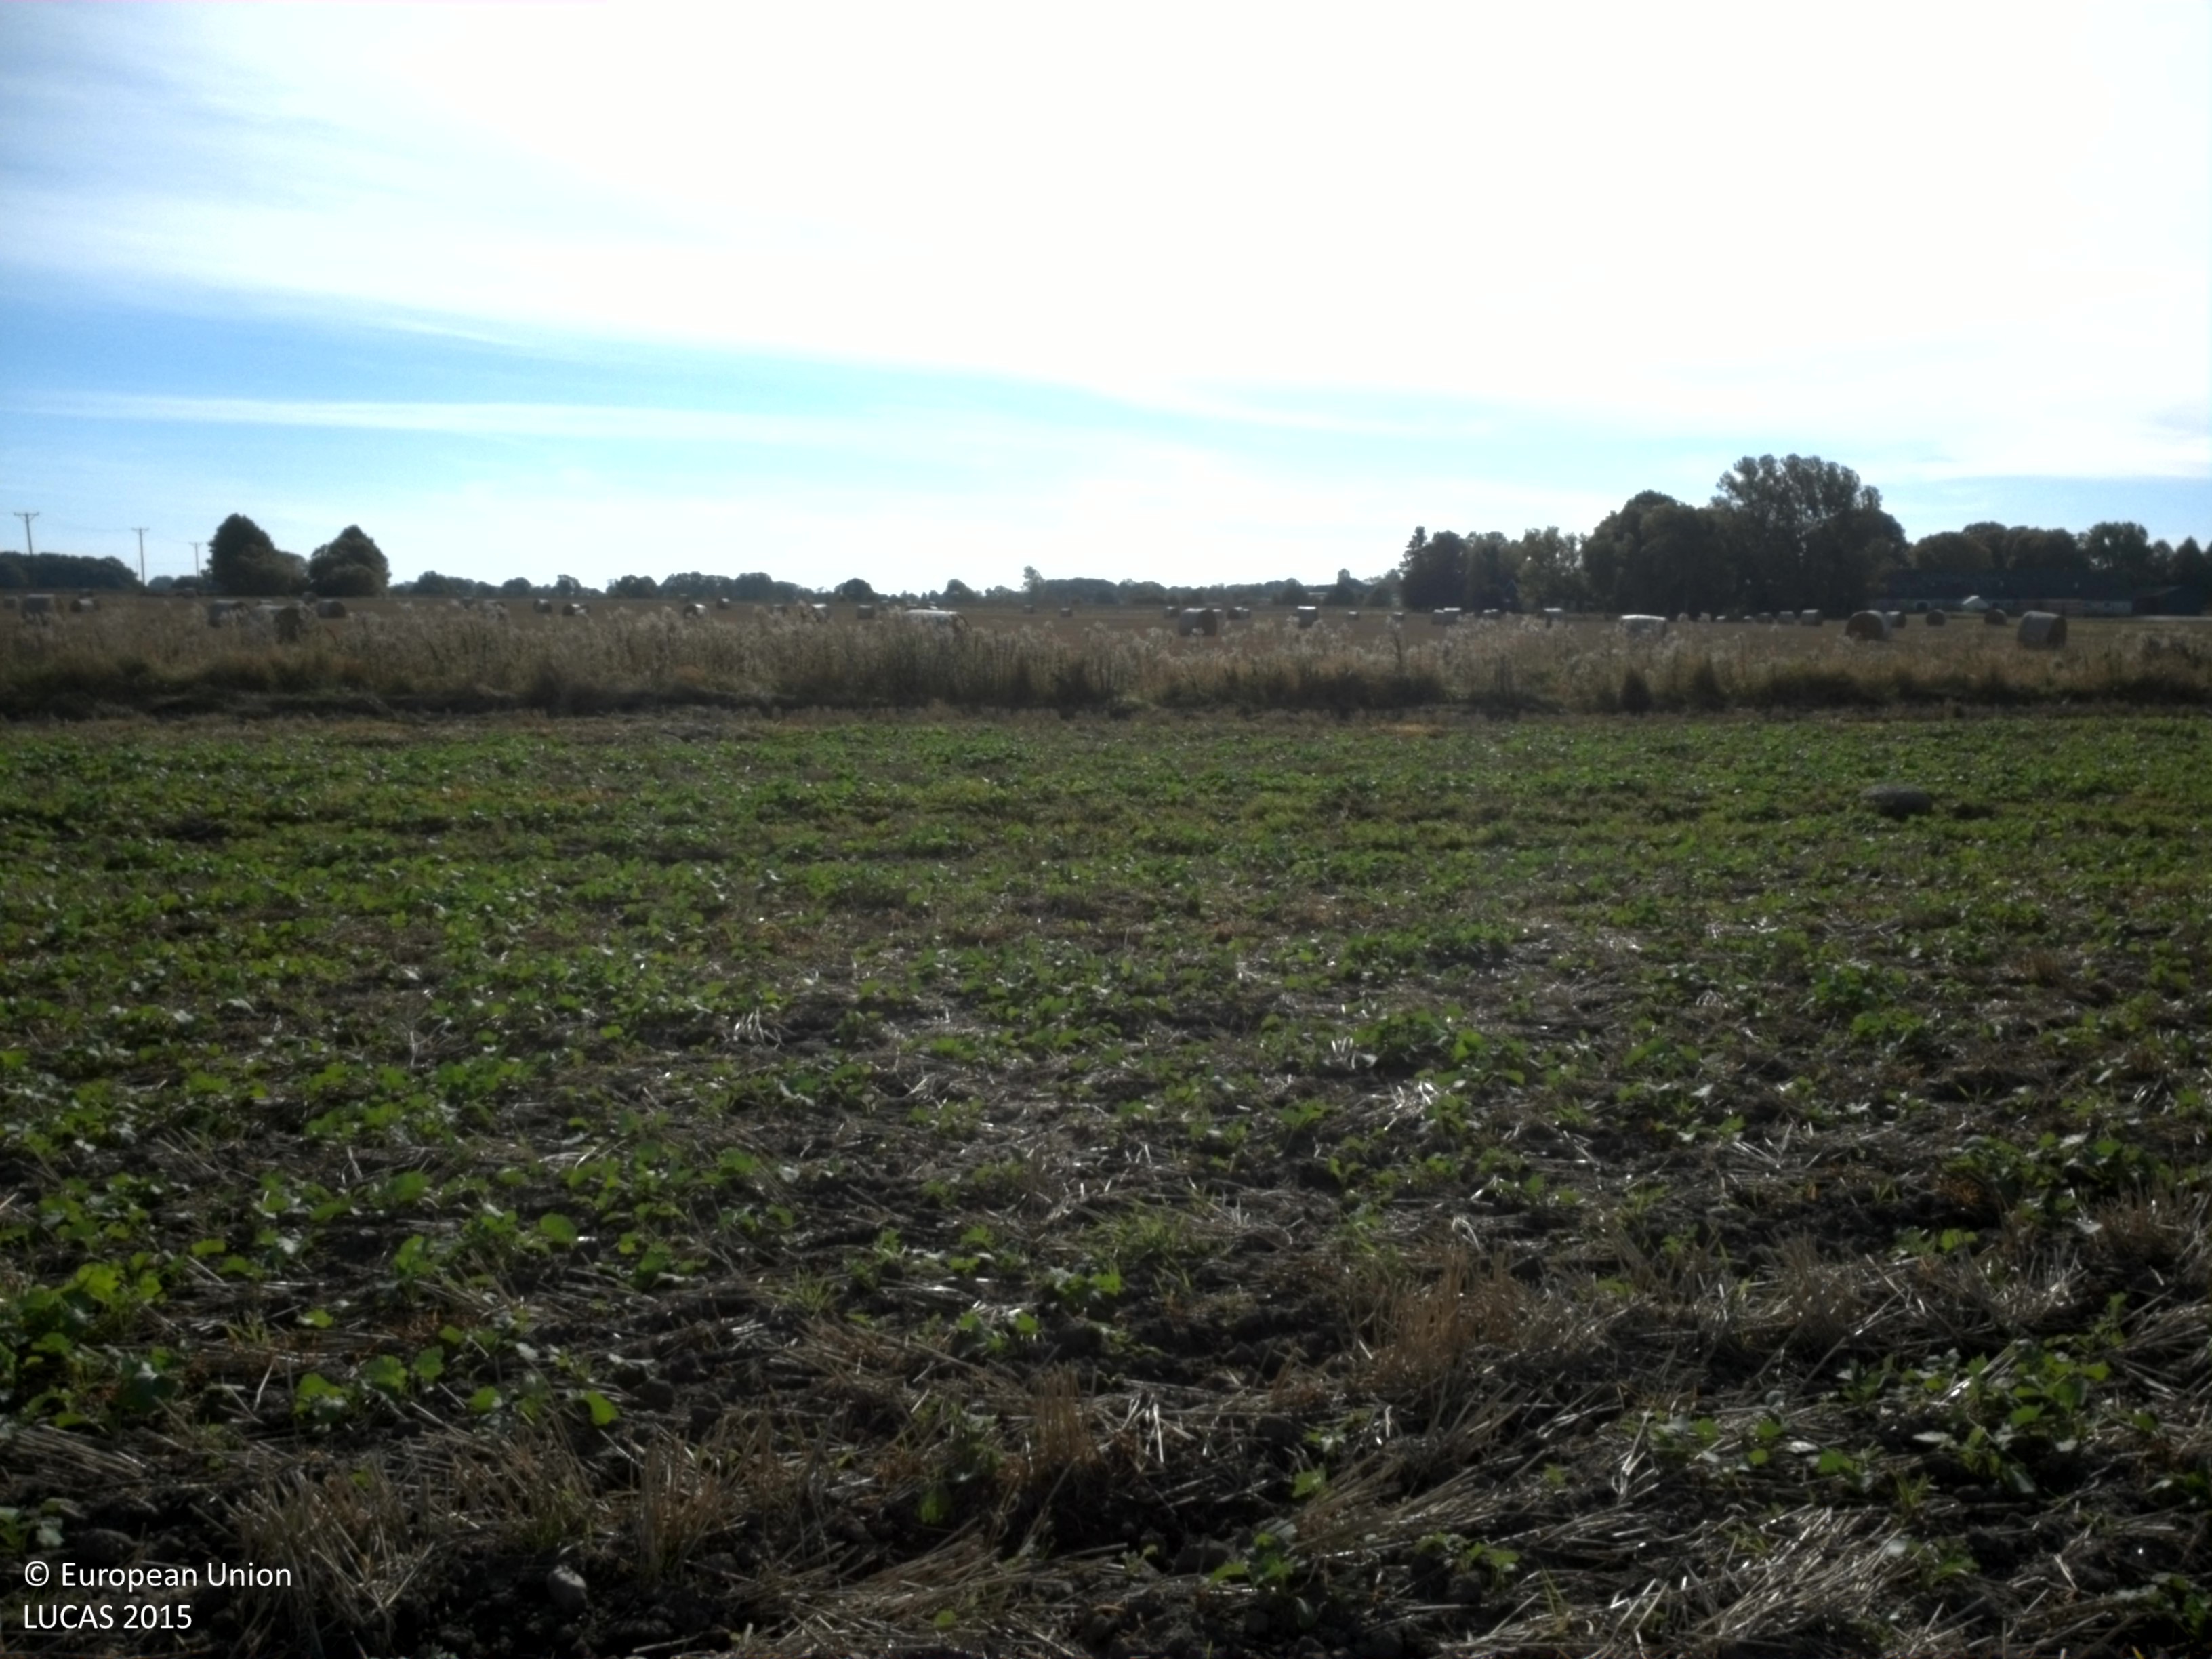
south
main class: Cropland
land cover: Rape and turnip rape
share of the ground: 25 - 50 %
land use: Agriculture (excluding fallow land and kitchen gardens)
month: October
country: SE
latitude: 55.7751
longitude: 13.6806
